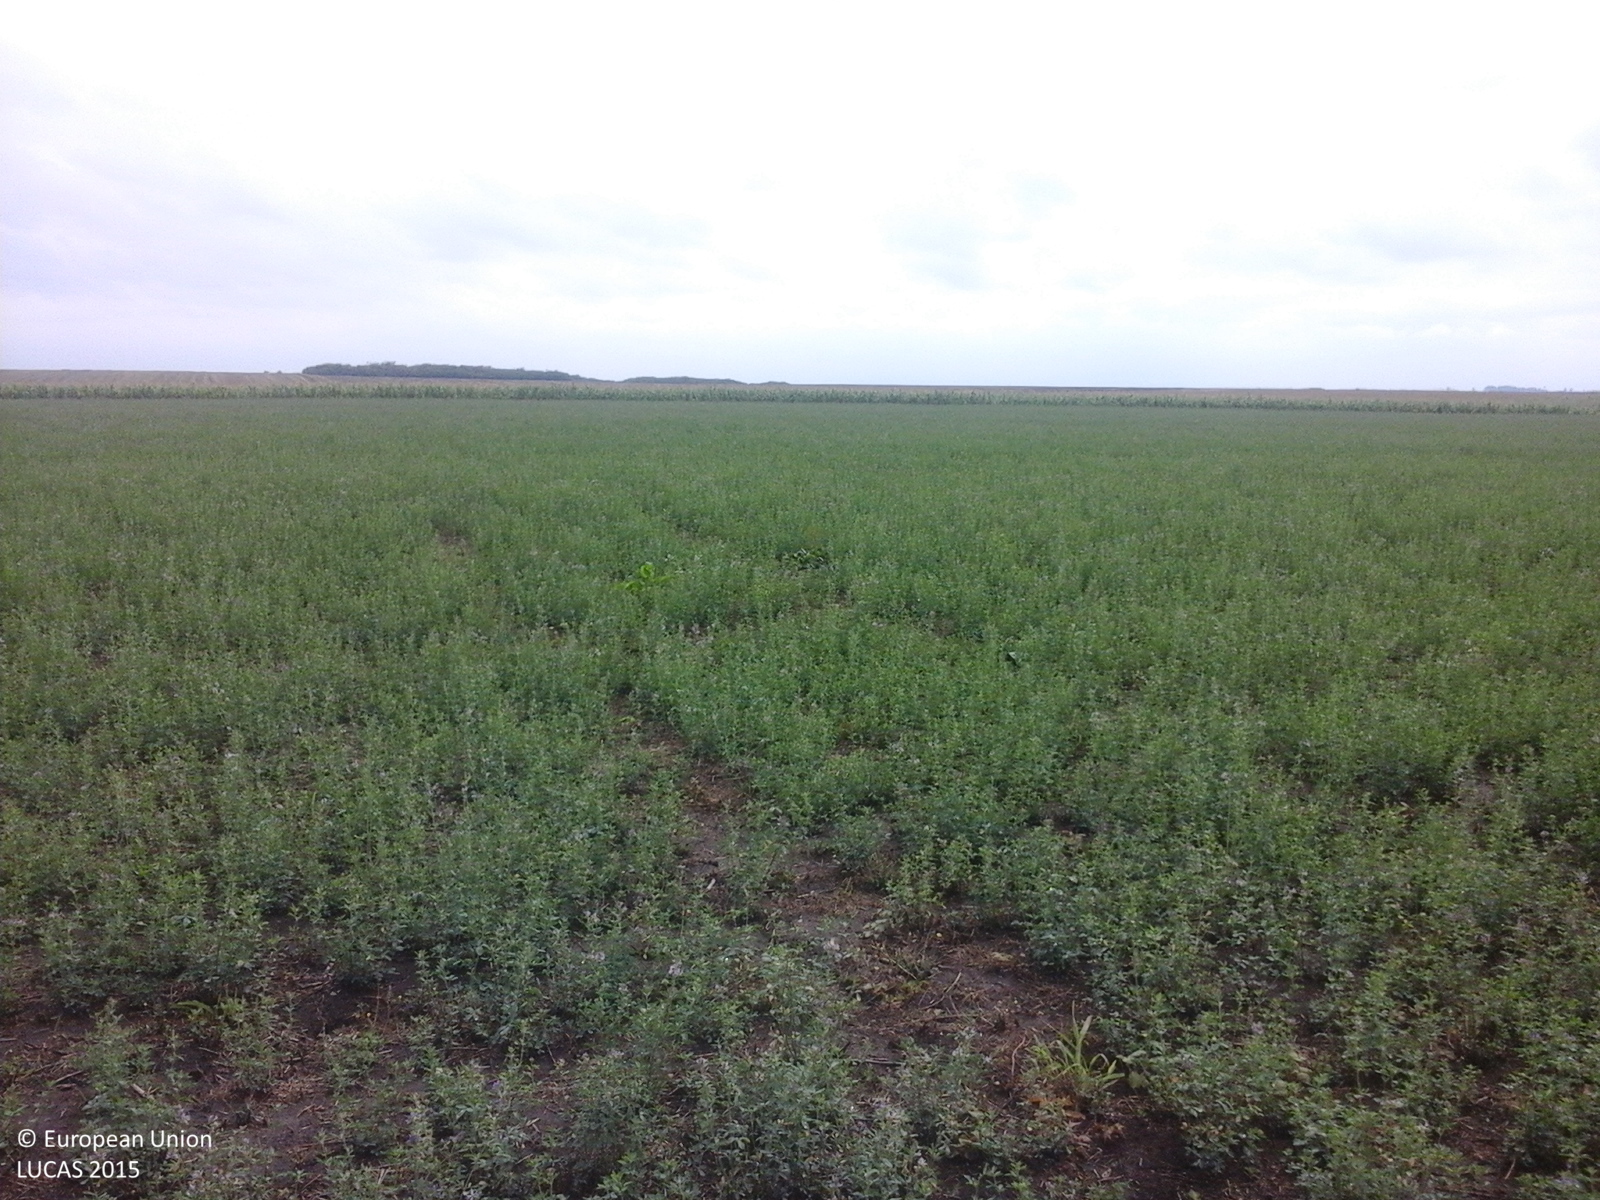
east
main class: Cropland
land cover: Lucerne
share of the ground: > 75 %
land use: Agriculture (excluding fallow land and kitchen gardens)
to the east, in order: Lucerne; Maize; Common wheat; Grass margins; Tracks; Grass margins; Other bare soil
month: August
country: RO
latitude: 45.5364
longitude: 21.2605
